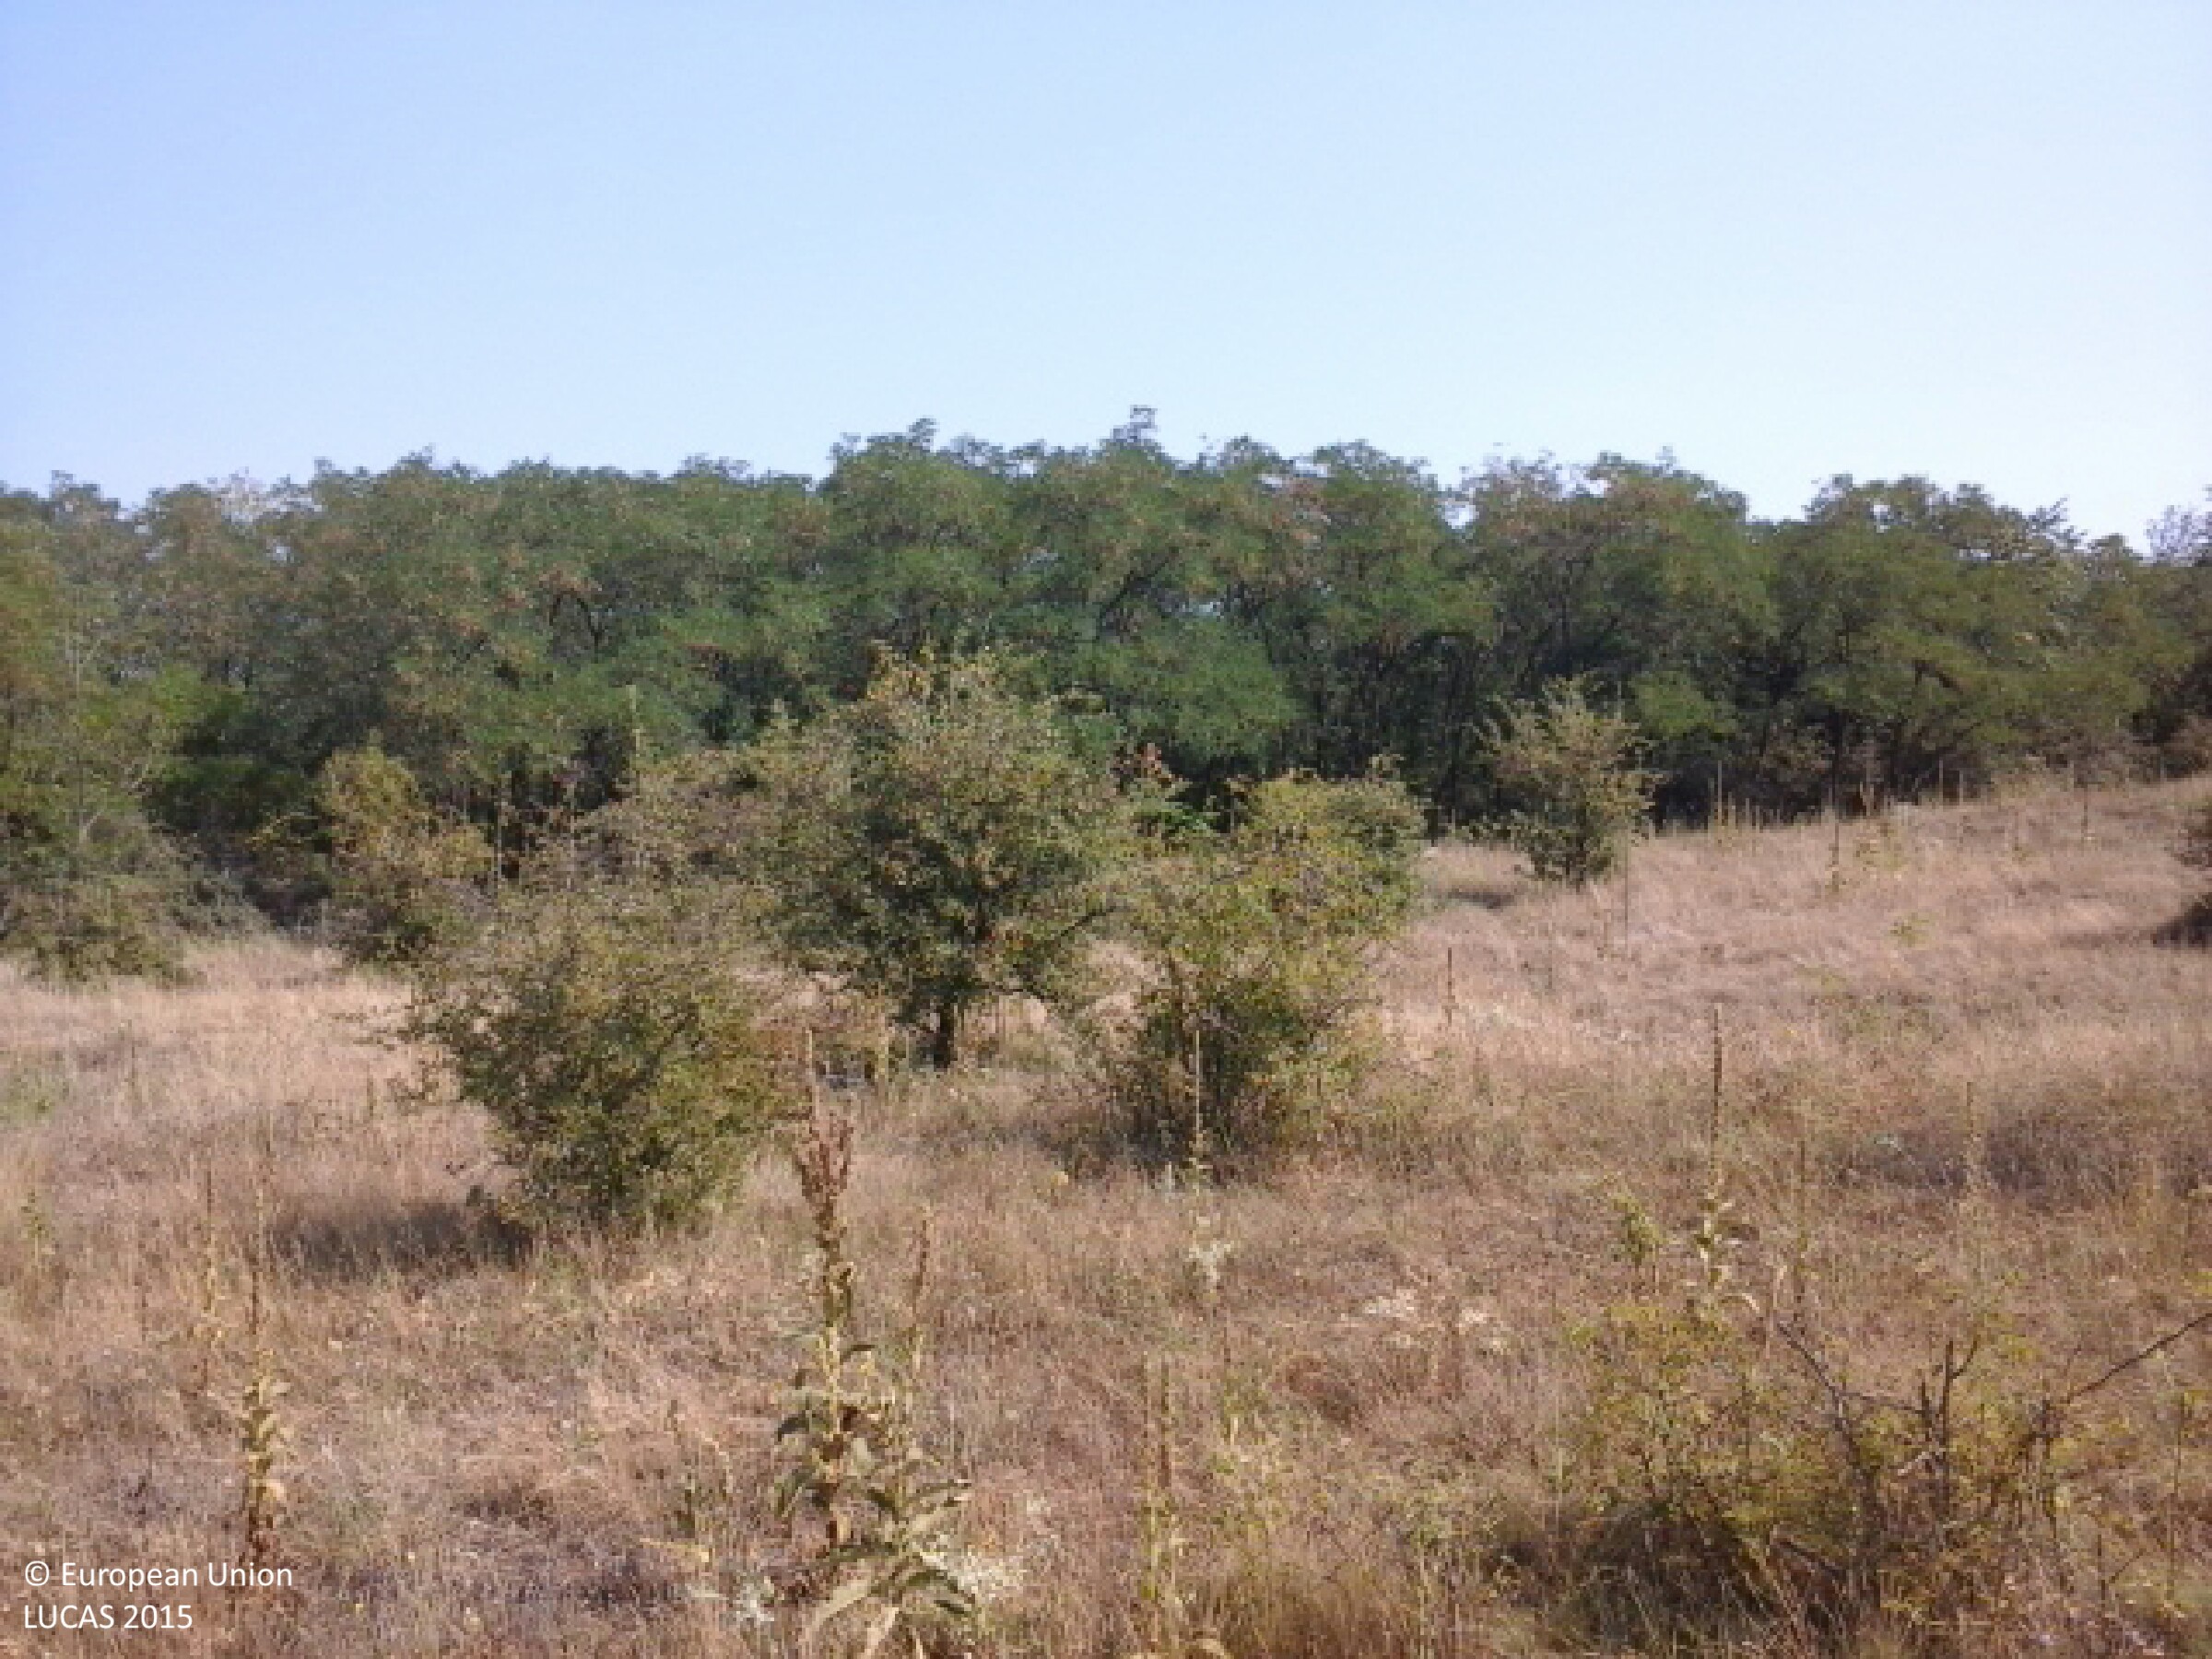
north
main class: Grassland
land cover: Grassland with sparse tree/shrub cover
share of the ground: > 75 %
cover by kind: herbaceous plants 90 %, broadleaved forest trees 5 %, shrubs 5 %
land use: Semi-natural and natural areas not in use
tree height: < 5 m
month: August
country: HU
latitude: 47.2249
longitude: 18.5048
